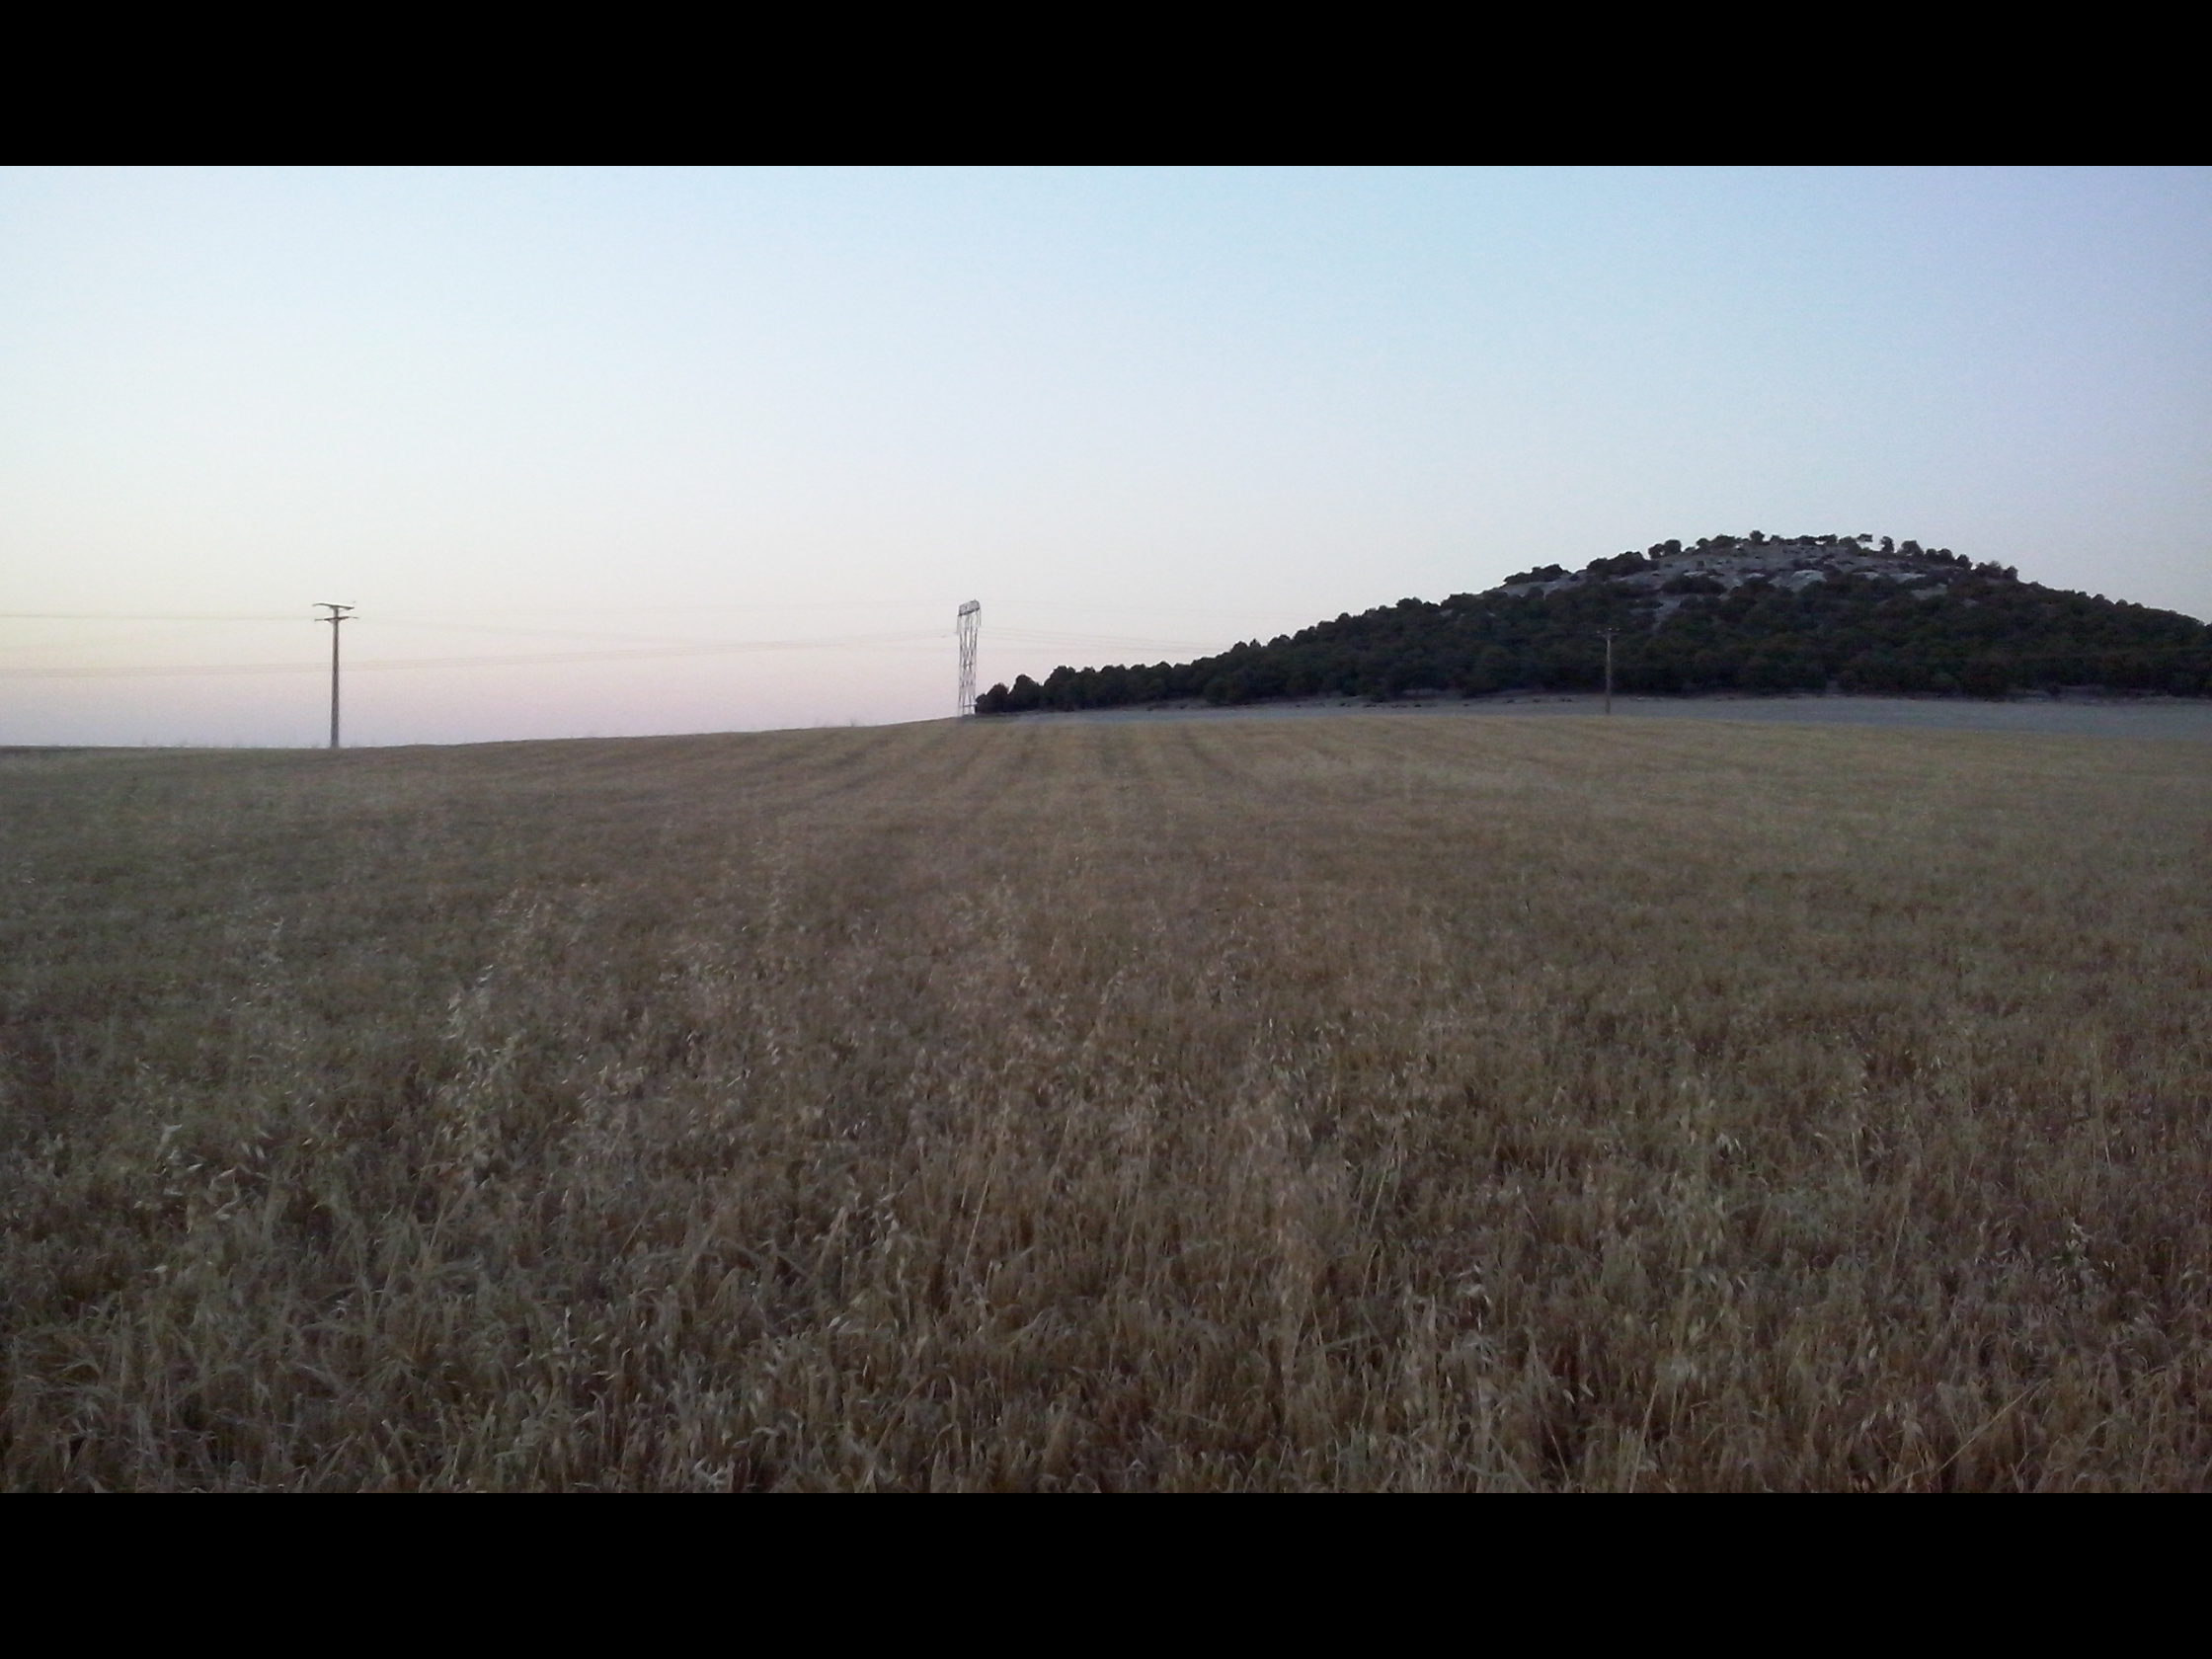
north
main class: Cropland
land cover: Barley
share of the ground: > 75 %
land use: Agriculture (excluding fallow land and kitchen gardens)
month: June
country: ES
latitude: 41.5938
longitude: -5.1806
